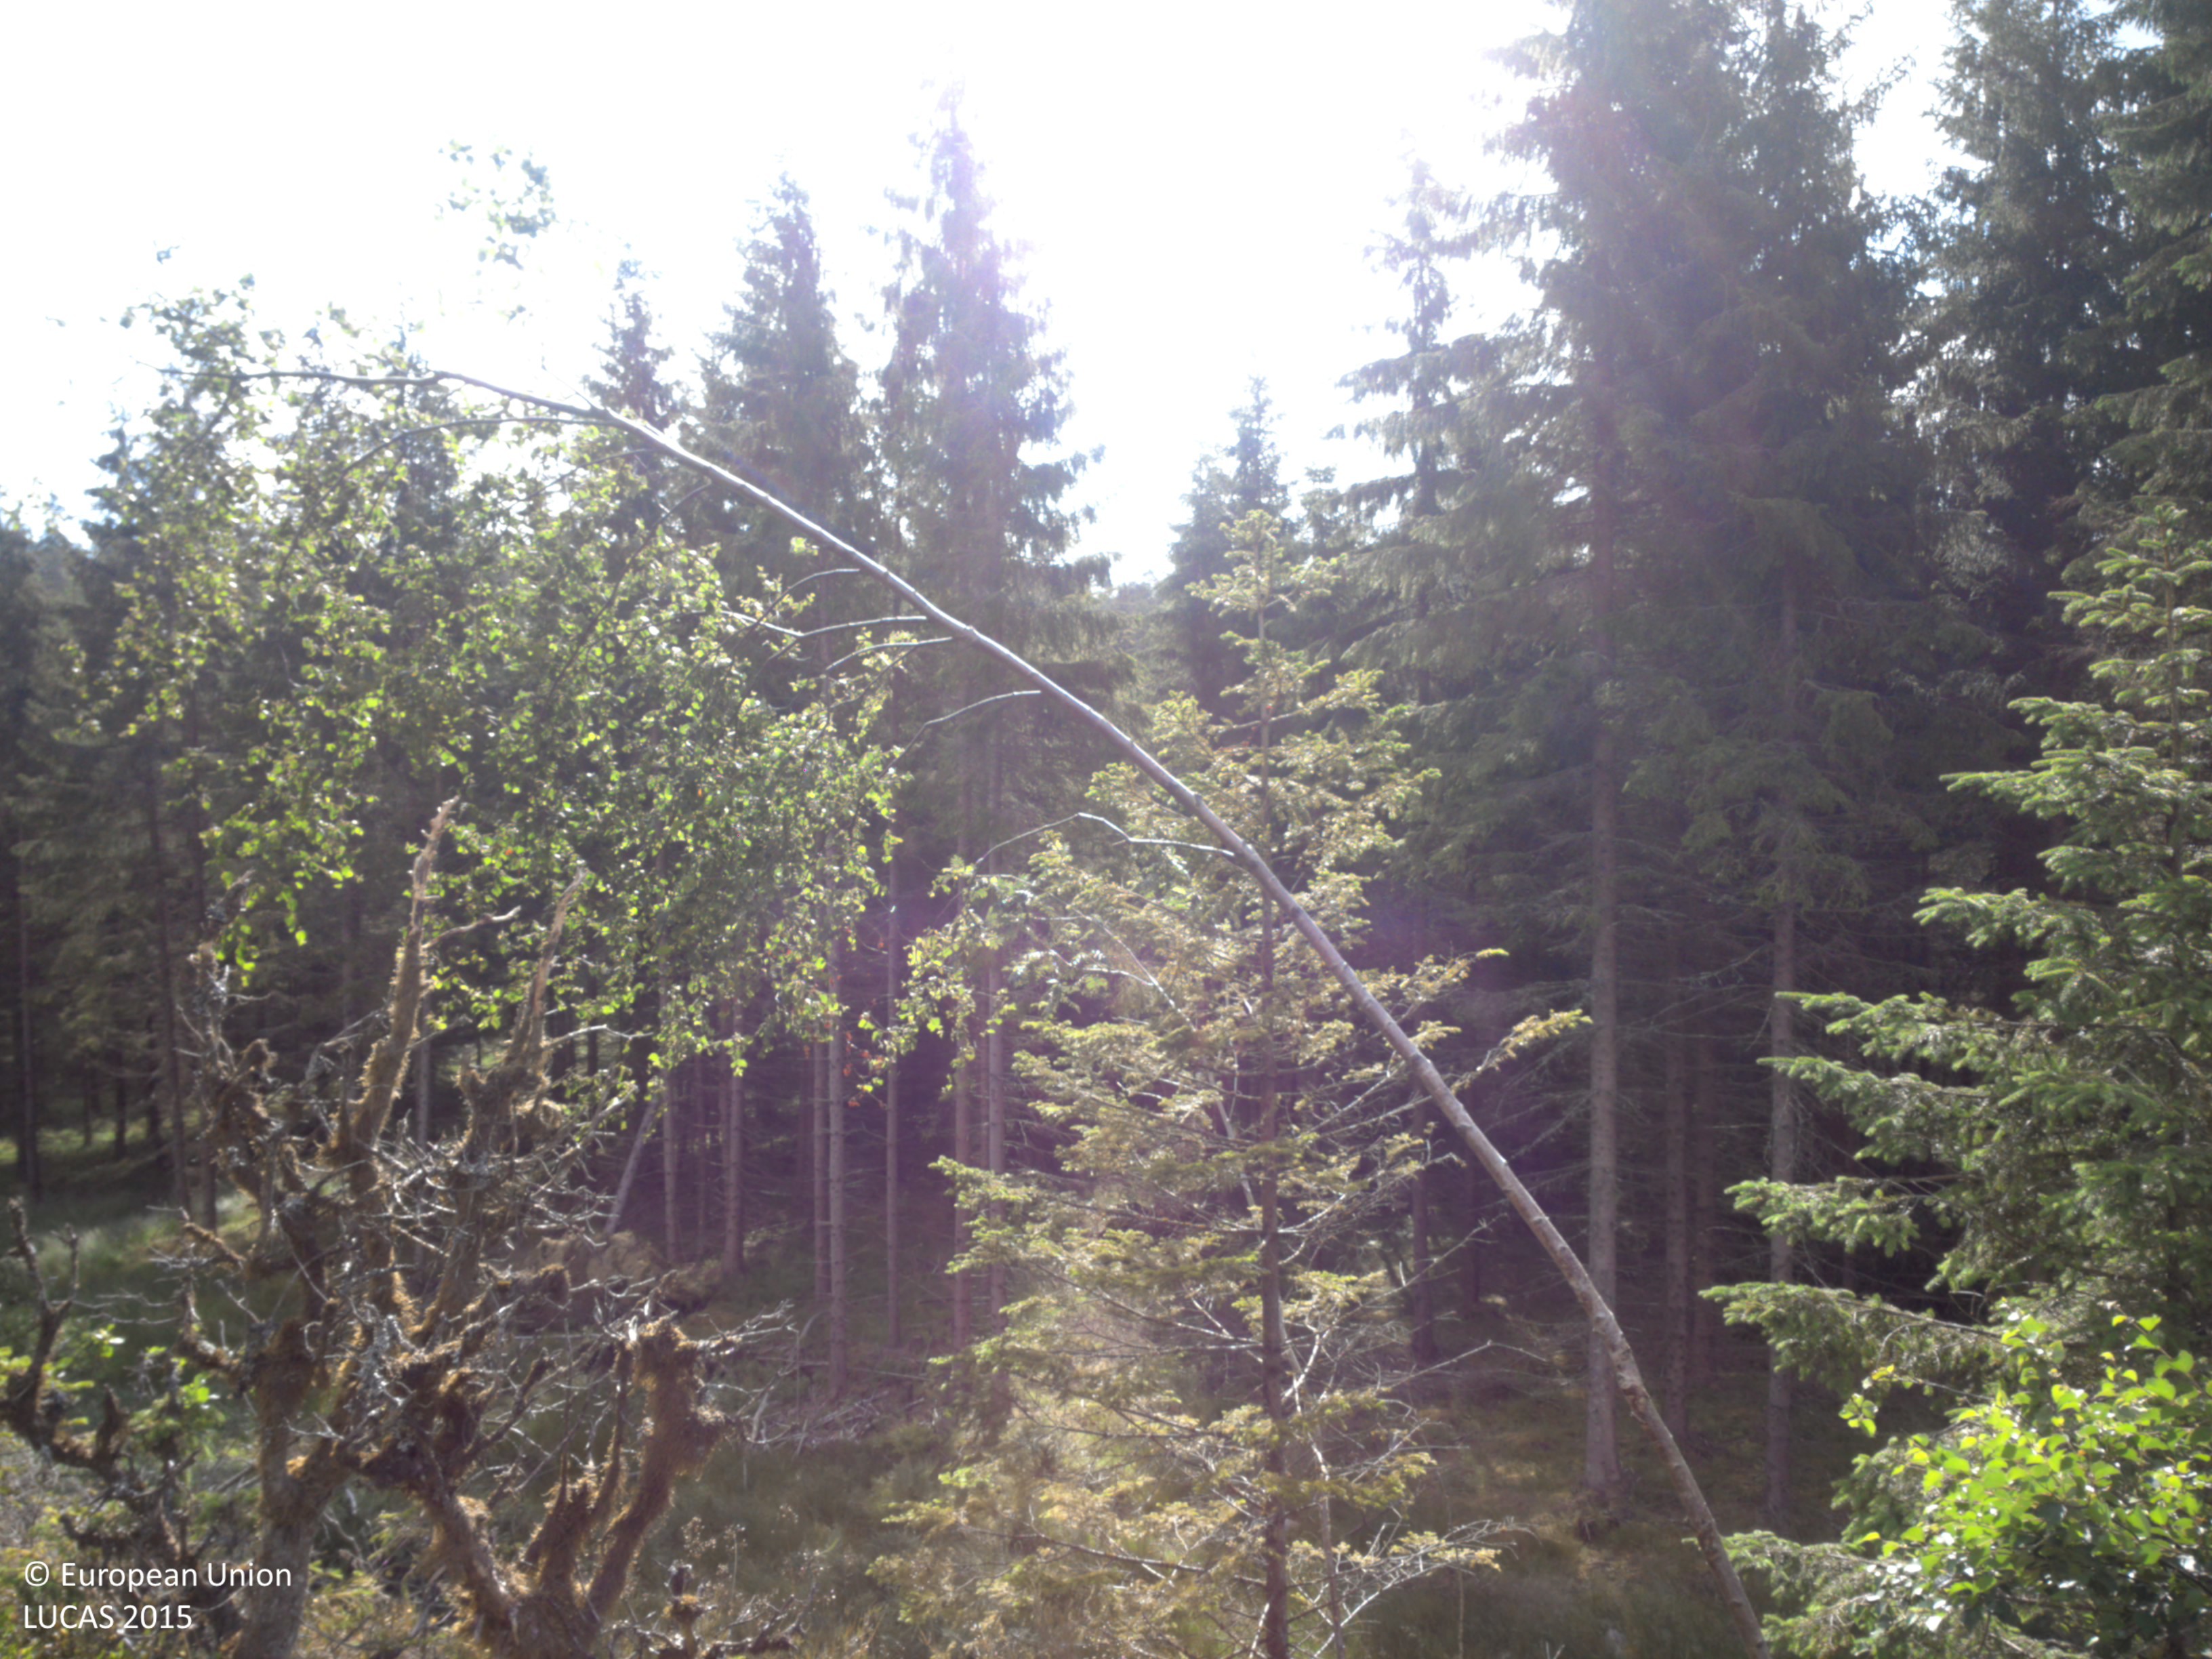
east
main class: Shrubland
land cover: Shrubland with sparse tree cover
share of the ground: 25 - 50 %
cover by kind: herbaceous plants 60 %, shrubs 30 %, broadleaved forest trees 5 %, lichens and mosses 5 %
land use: Forestry
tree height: > 5 m
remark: Clear cut
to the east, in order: Shrubland with sparse tree cover; Rock outcrops; Shrubland with sparse tree cover; Spruce dominated coniferous woodland; Spruce dominated mixed woodland; Spruce dominated coniferous woodland
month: July
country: SE
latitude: 58.8010
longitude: 11.8132
